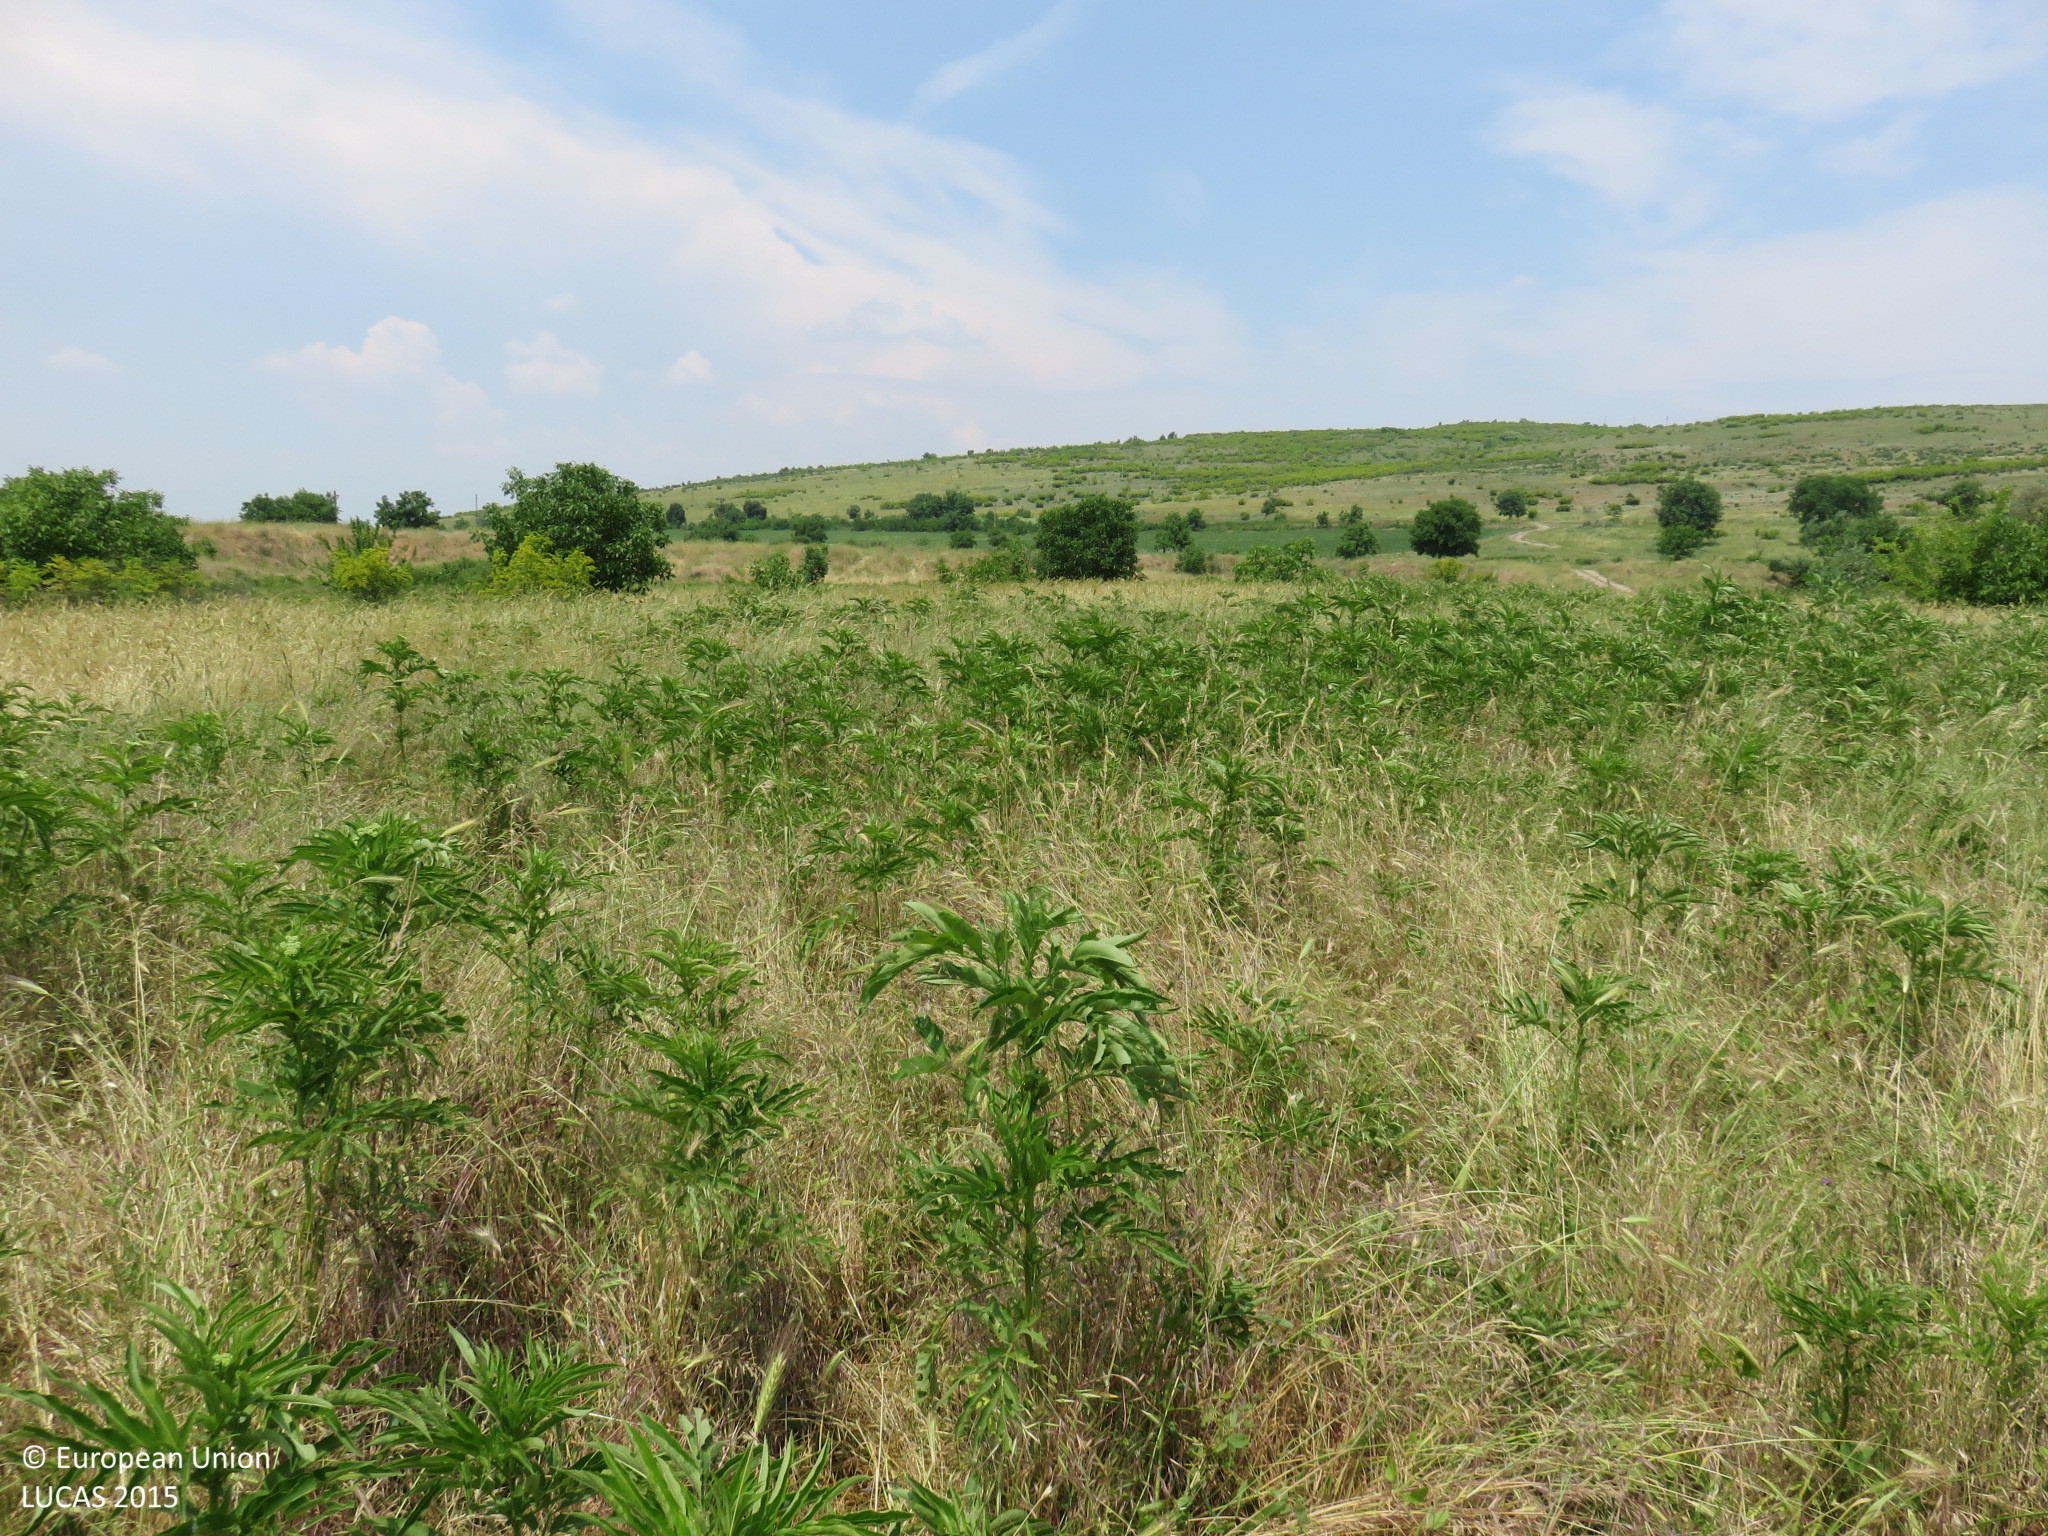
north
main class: Grassland
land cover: Grassland without tree/shrub cover
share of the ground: > 75 %
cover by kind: herbaceous plants 100 %
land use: Agriculture (excluding fallow land and kitchen gardens)
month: June
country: BG
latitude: 43.3787
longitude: 24.5141
